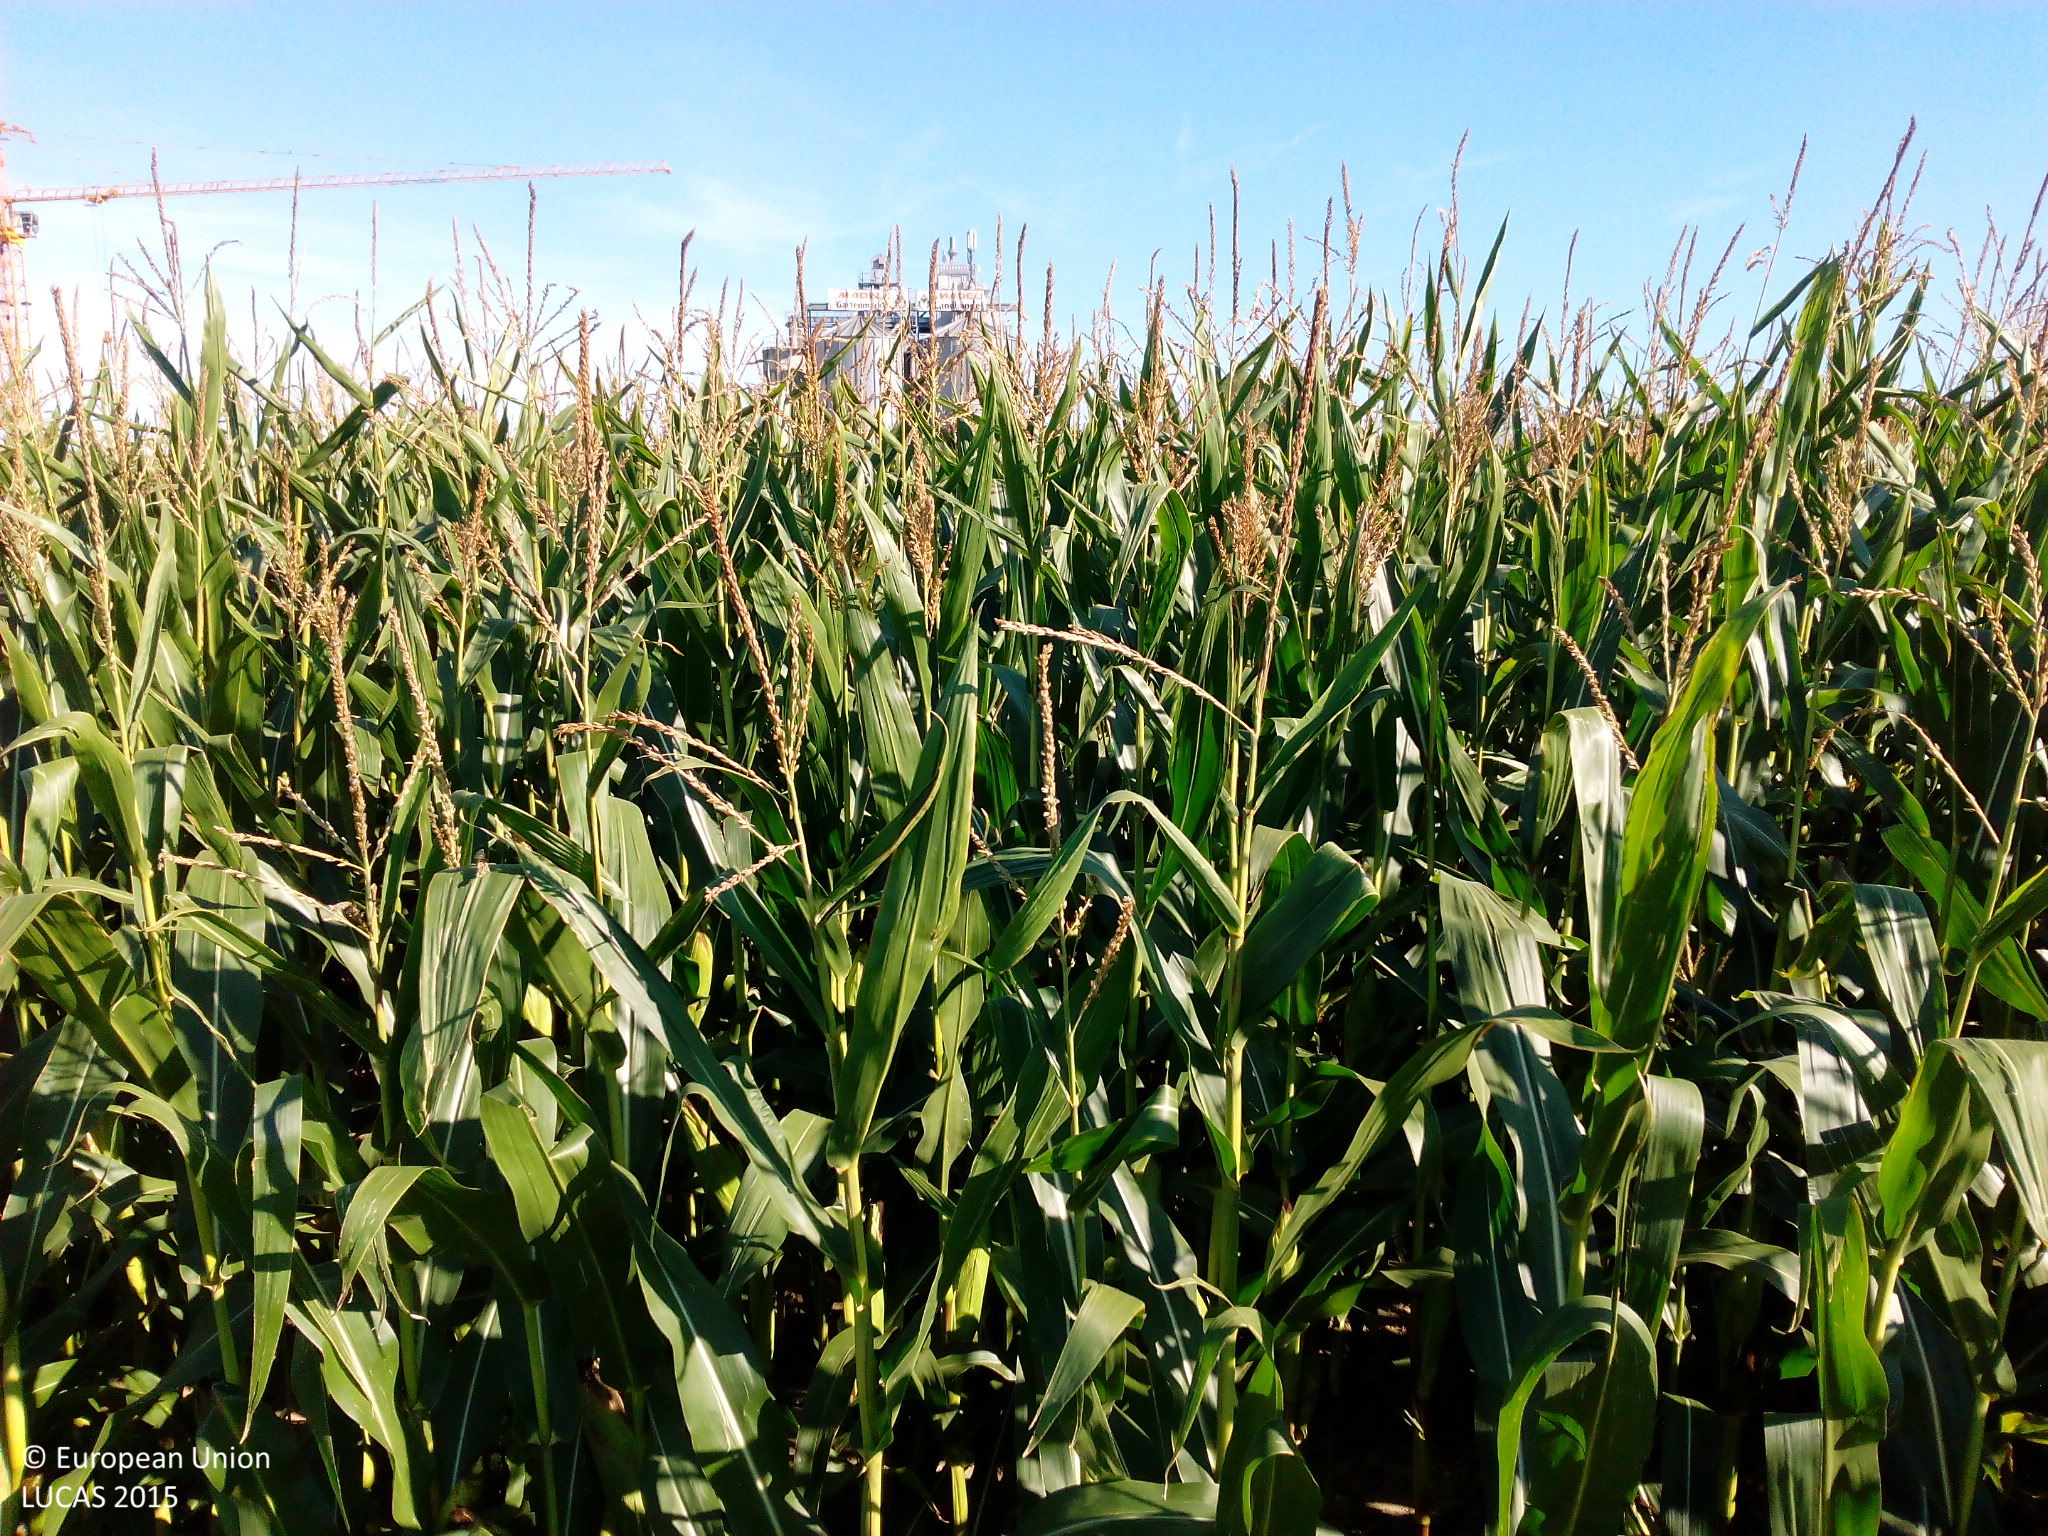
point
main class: Cropland
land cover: Maize
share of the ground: > 75 %
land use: Agriculture (excluding fallow land and kitchen gardens)
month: August
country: DE
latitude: 48.3315
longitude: 9.9596
